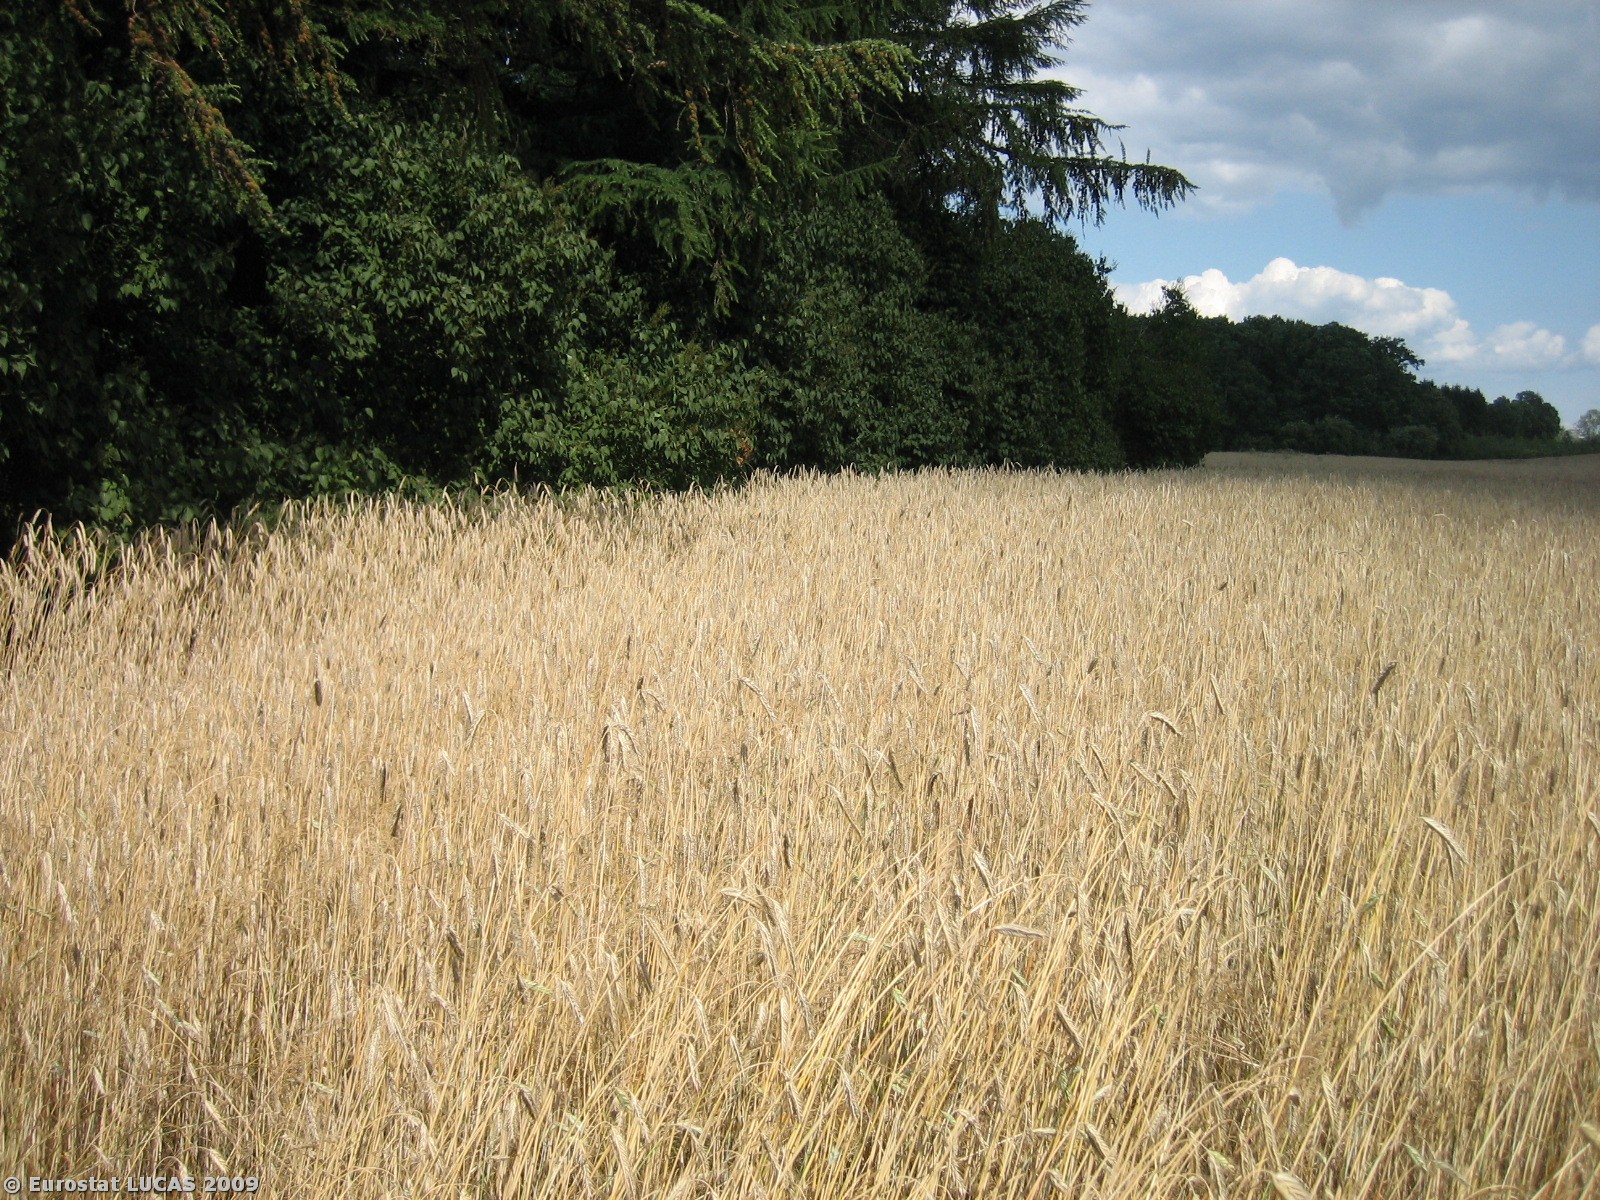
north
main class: Cropland
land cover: Rye
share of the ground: > 75 %
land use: Agriculture (excluding fallow land and kitchen gardens)
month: July
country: DK
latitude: 55.5047
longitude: 10.0158
